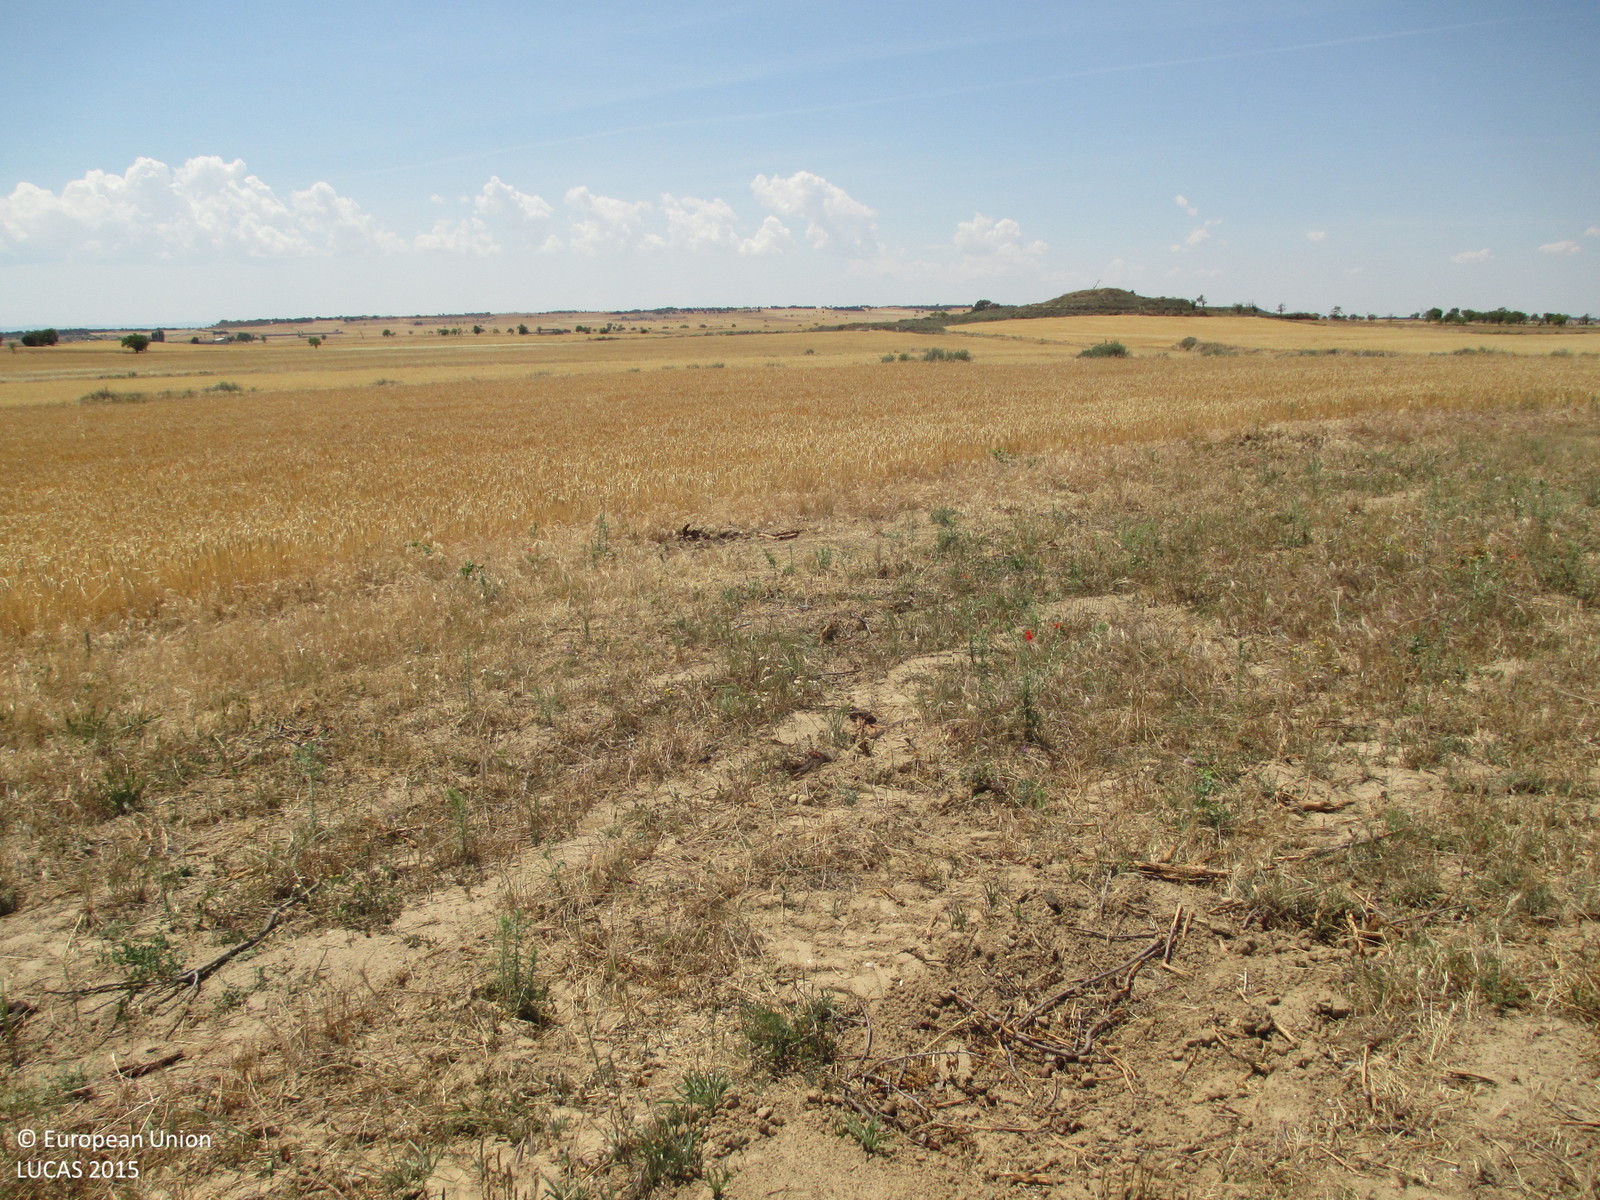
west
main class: Grassland
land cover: Spontaneously vegetated surfaces
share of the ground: 50 - 75 %
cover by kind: herbaceous plants 65 %, unconsolidated bare surface 35 %
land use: Fallow land
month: May
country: ES
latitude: 41.9559
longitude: -0.0199
